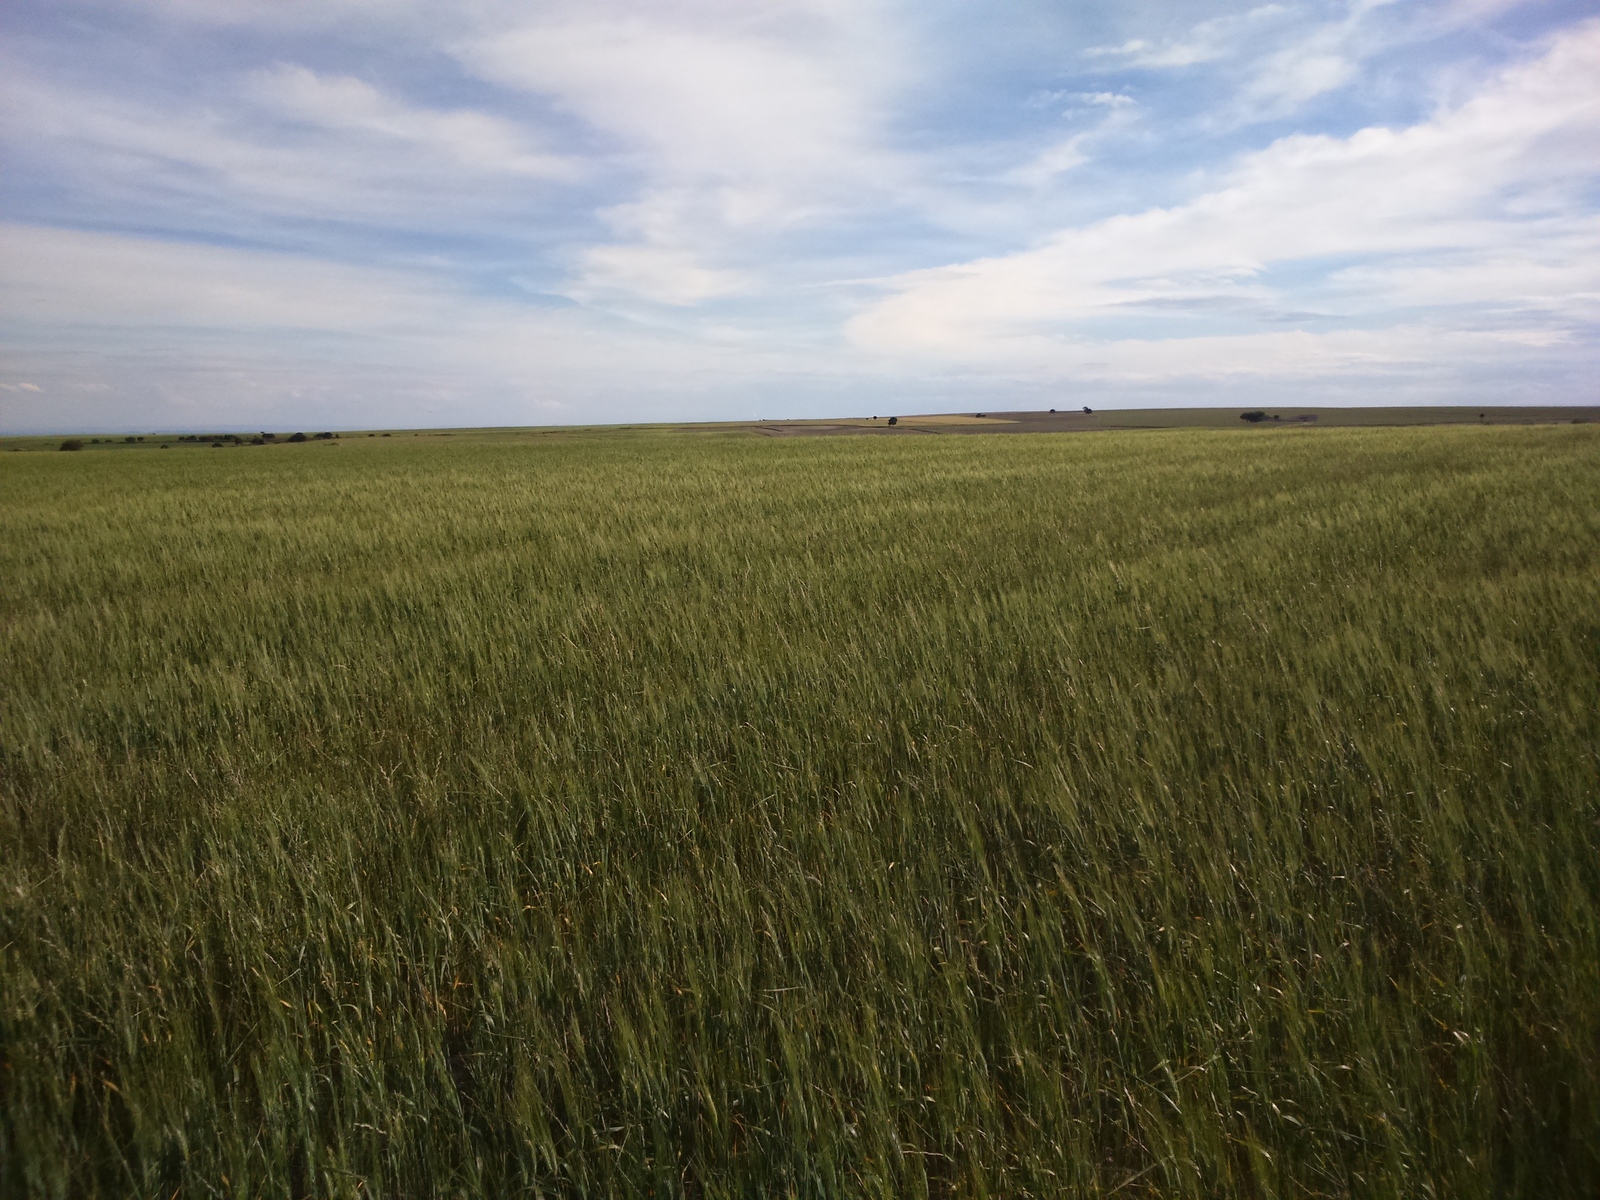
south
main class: Cropland
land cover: Durum wheat
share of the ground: > 75 %
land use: Agriculture (excluding fallow land and kitchen gardens)
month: April
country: ES
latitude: 41.4592
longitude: -0.2517
